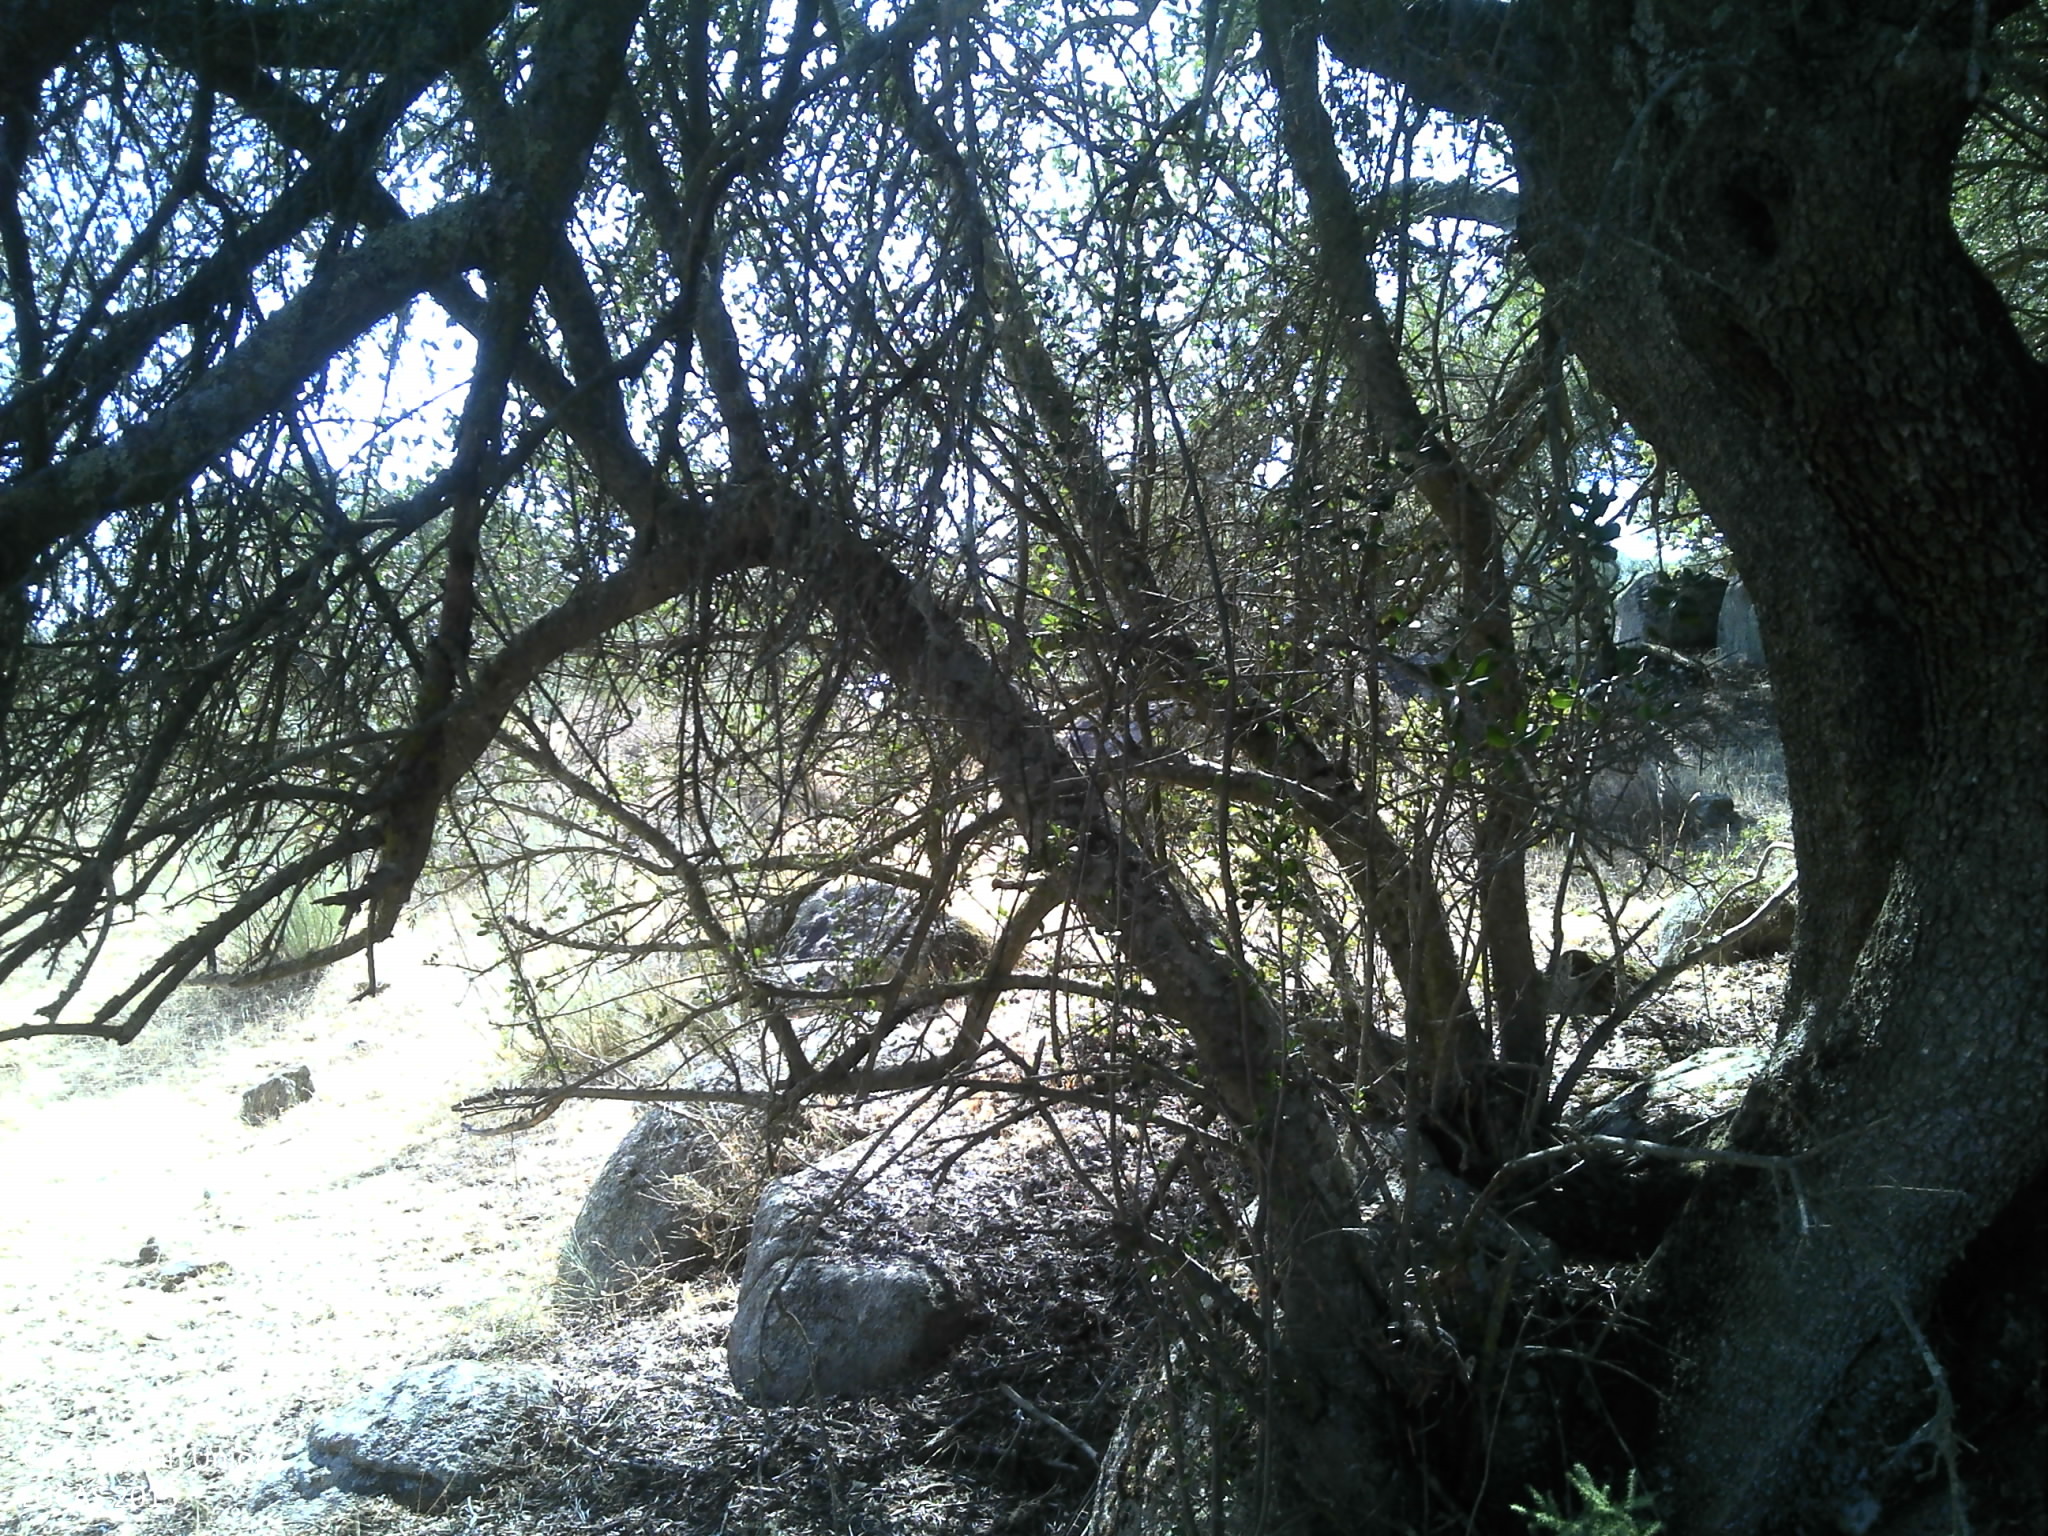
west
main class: Cropland
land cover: Olive groves
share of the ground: 25 - 50 %
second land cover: Shrubland without tree cover
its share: 50 - 75 %
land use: Abandoned areas
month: July
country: PT
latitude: 39.0368
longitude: -7.4708
